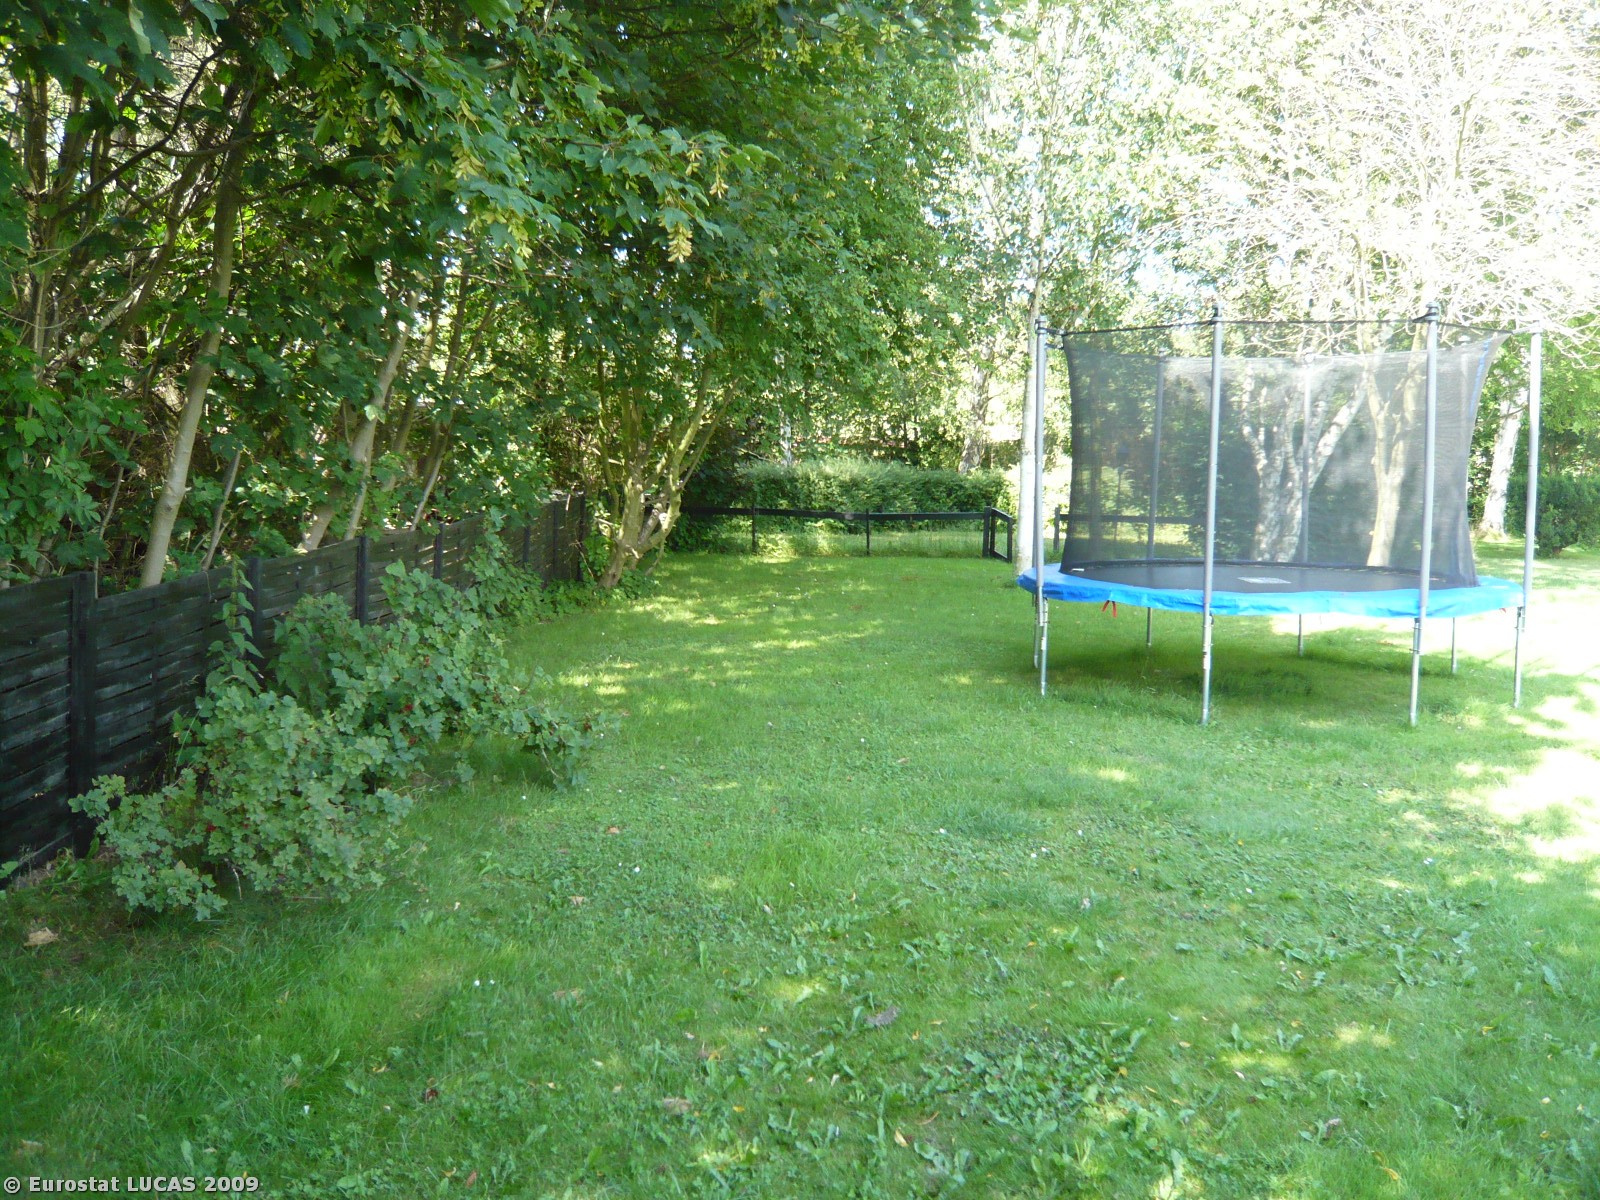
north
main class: Grassland
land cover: Grassland without tree/shrub cover
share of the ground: > 75 %
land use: Agriculture (excluding fallow land and kitchen gardens)
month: July
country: DK
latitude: 55.7809
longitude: 11.7044
